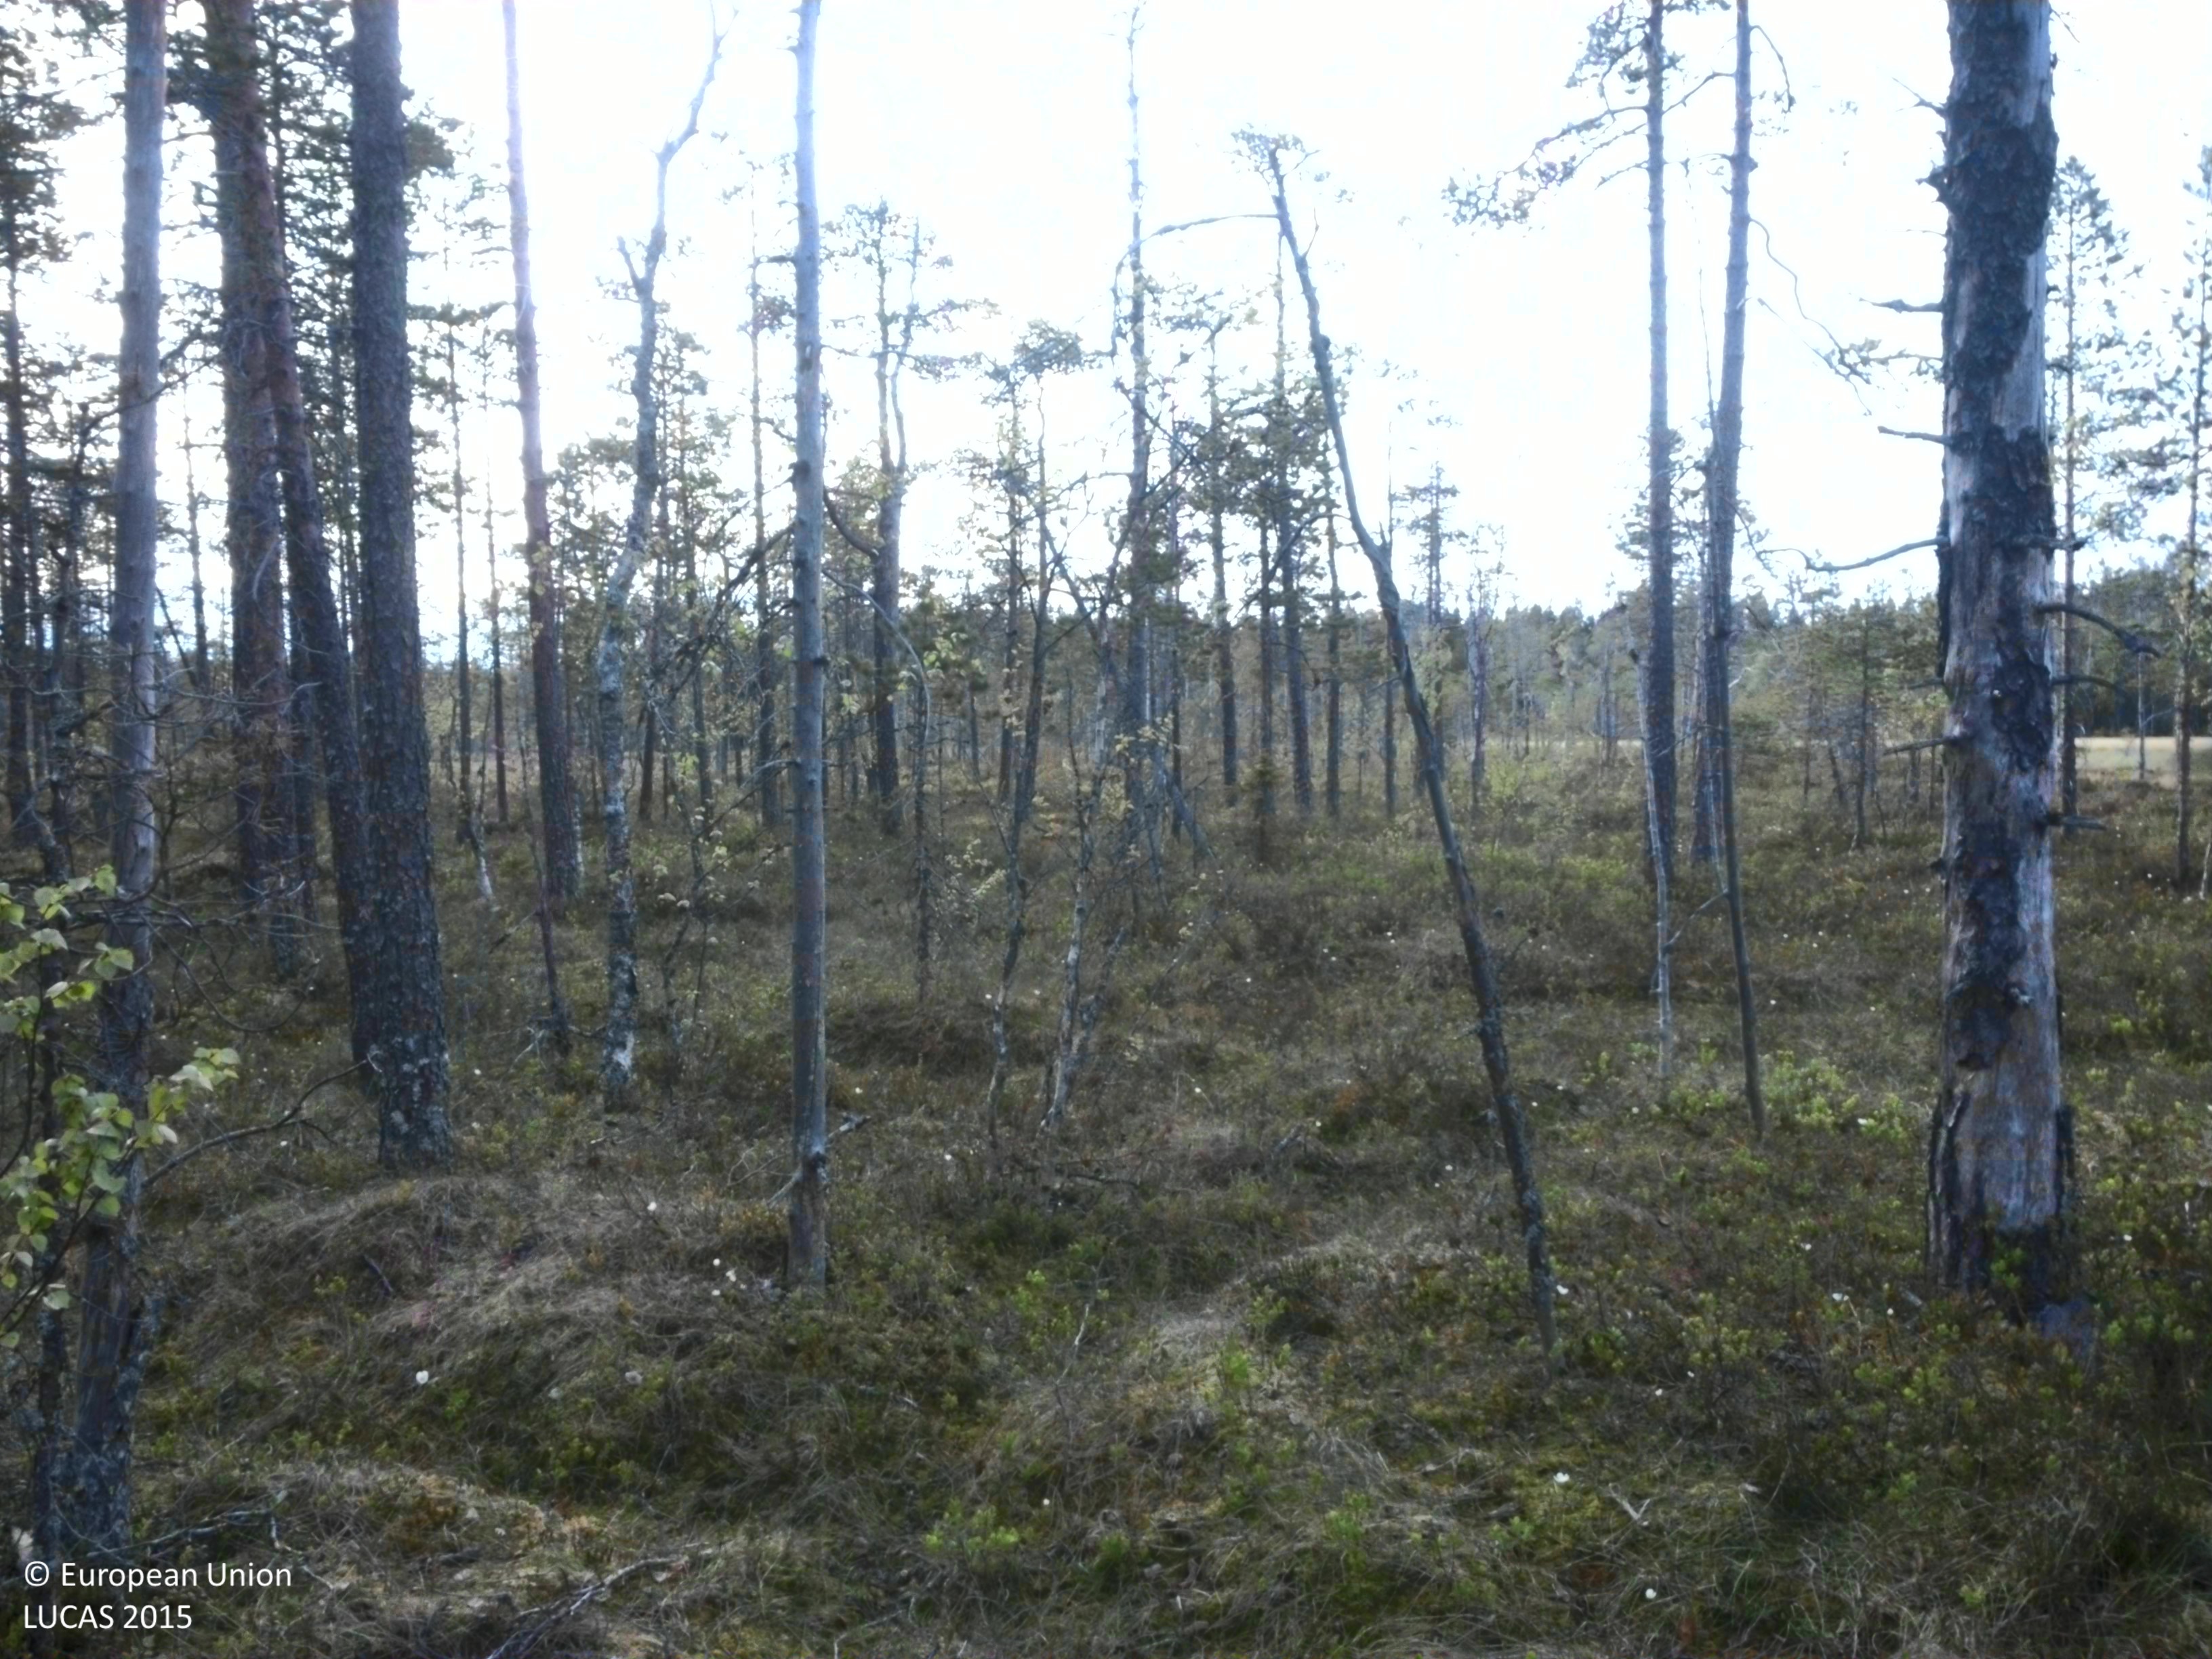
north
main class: Woodland
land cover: Pine dominated mixed woodland
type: boreal forest
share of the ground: 25 - 50 %
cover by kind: coniferous forest trees 30 %, shrubs 20 %, herbaceous plants 20 %, lichens and mosses 20 %, broadleaved forest trees 10 %
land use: Forestry
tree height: > 5 m
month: June
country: SE
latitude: 63.8557
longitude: 20.6635
